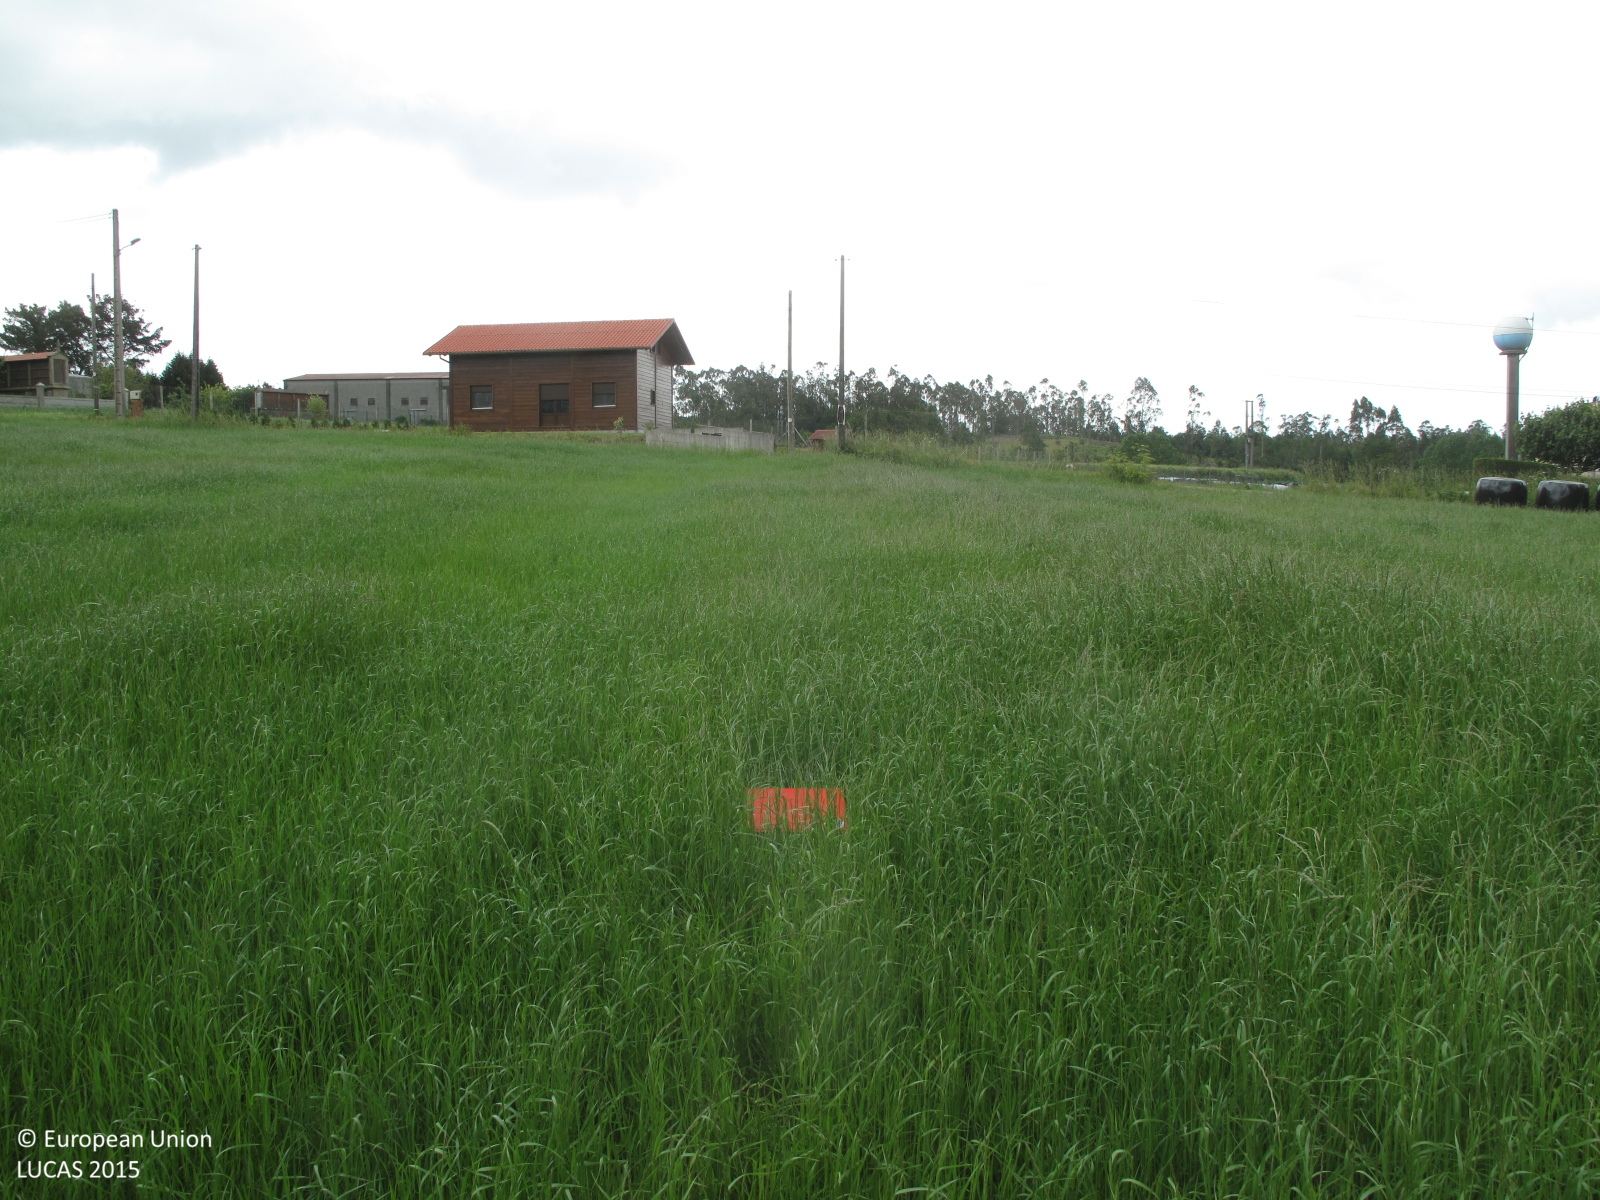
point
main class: Grassland
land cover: Grassland without tree/shrub cover
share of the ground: > 75 %
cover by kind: herbaceous plants 100 %
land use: Agriculture (excluding fallow land and kitchen gardens)
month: June
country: ES
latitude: 43.0592
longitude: -8.5878
